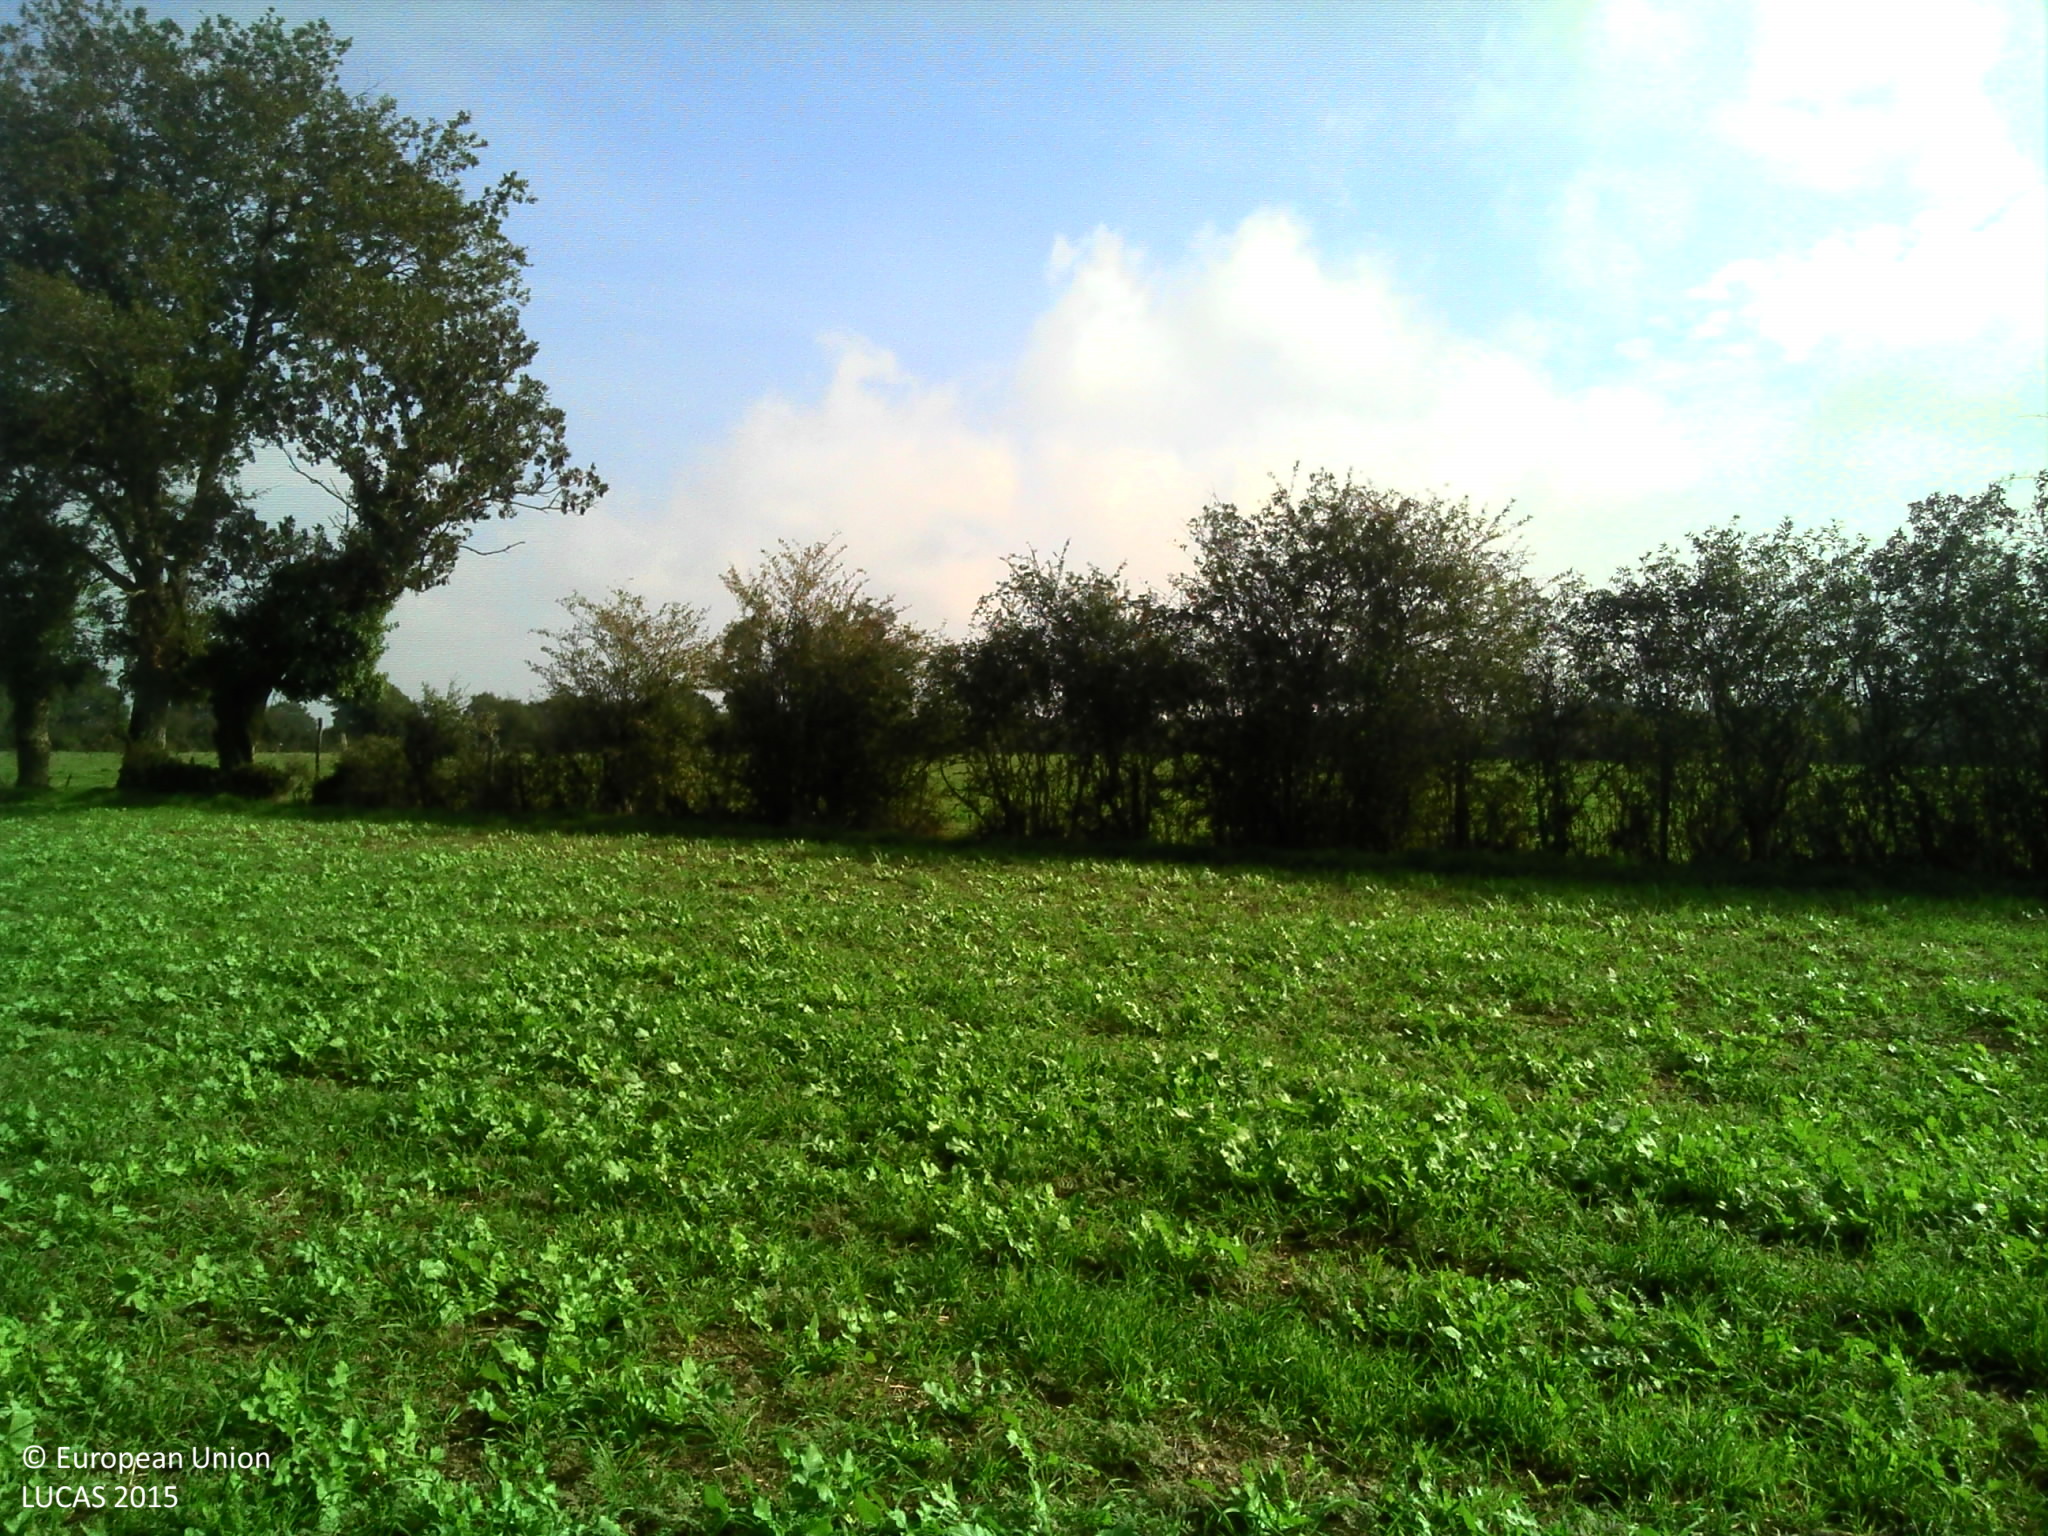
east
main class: Grassland
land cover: Spontaneously vegetated surfaces
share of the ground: > 75 %
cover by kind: herbaceous plants 95 %, unconsolidated bare surface 5 %
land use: Agriculture (excluding fallow land and kitchen gardens)
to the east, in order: Spontaneously vegetated surfaces; Fences; Abandoned hedges; Grassland without tree/shrub cover; Abandoned hedges; Fences; Temporary grasslands
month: October
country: FR
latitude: 47.0262
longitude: -0.9148
